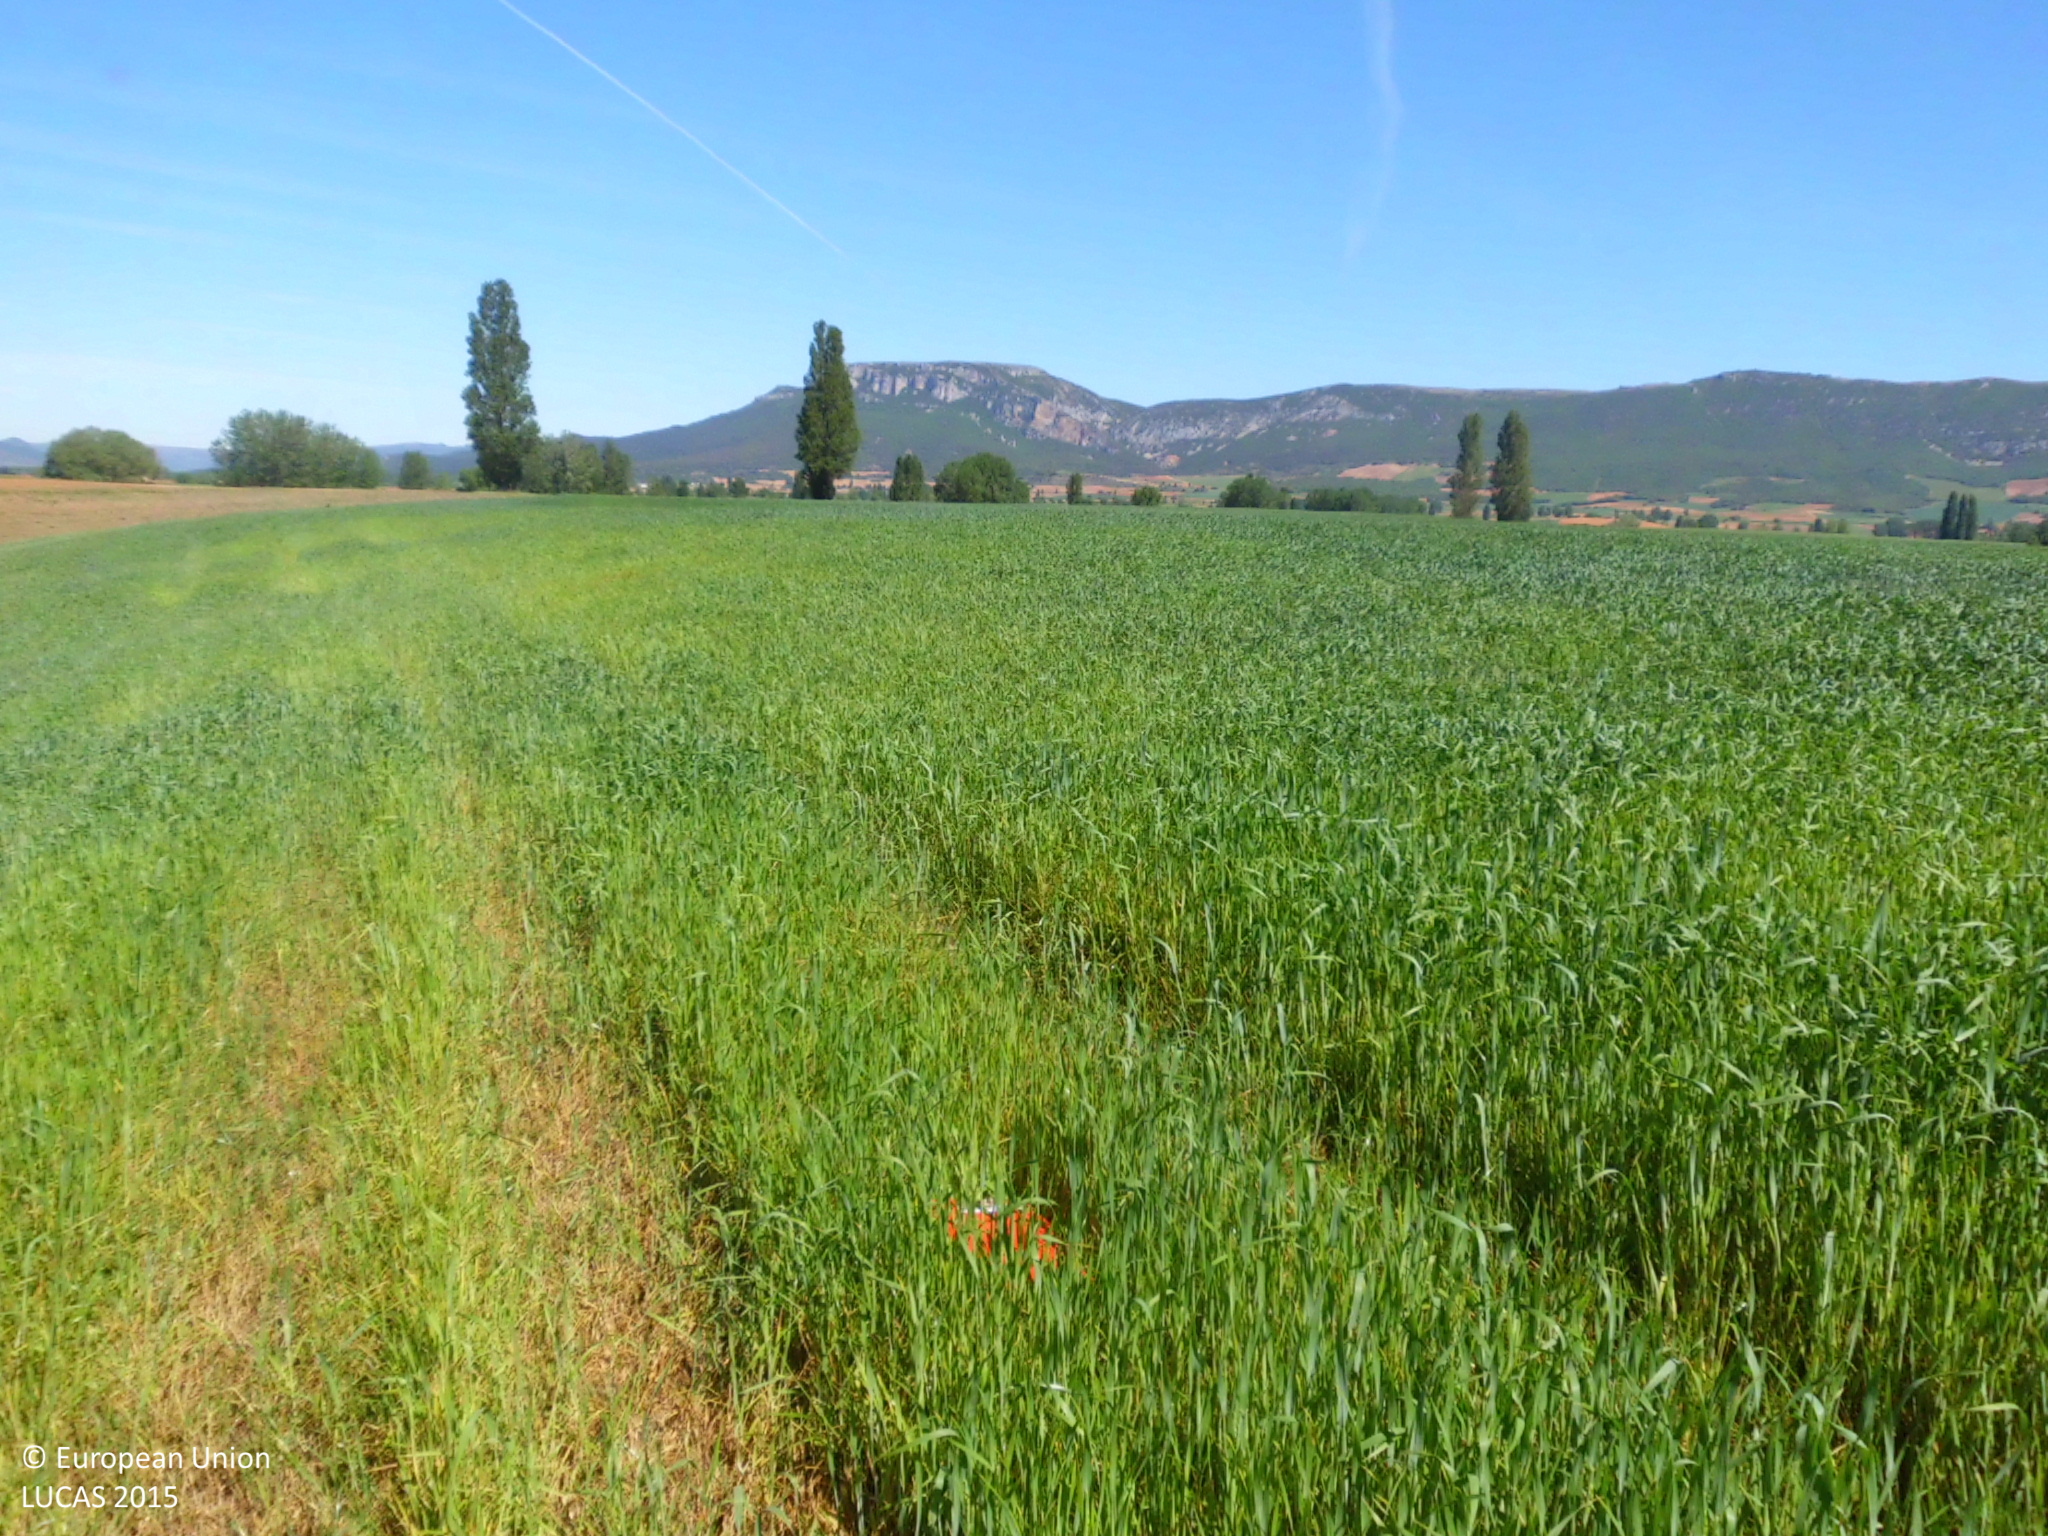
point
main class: Cropland
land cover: Common wheat
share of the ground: 50 - 75 %
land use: Agriculture (excluding fallow land and kitchen gardens)
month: May
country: ES
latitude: 42.6590
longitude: -3.3686
